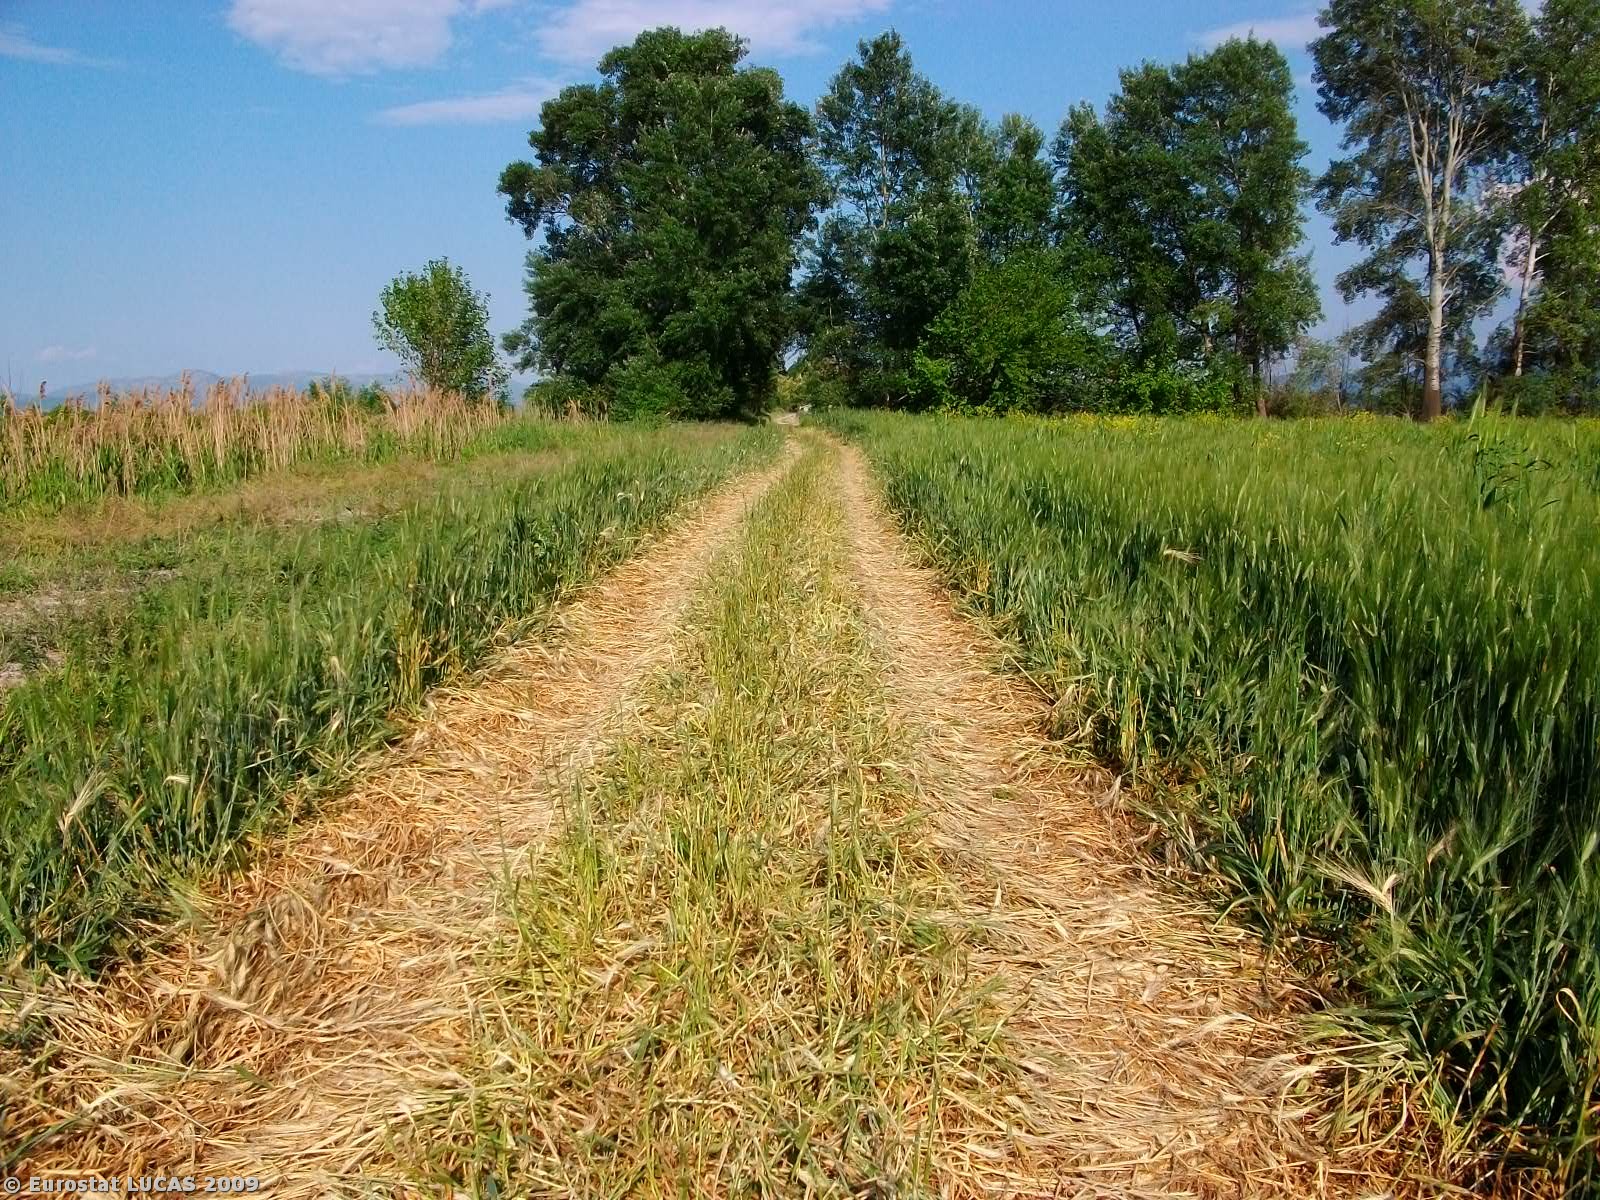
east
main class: Cropland
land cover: Durum wheat
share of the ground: > 75 %
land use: Agriculture (excluding fallow land and kitchen gardens)
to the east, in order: Durum wheat; Lines of trees; Ditches and canals; Paved roads, cycling and walking lanes; Lines of trees; Maize; Spontaneously vegetated surfaces
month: May
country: GR
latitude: 38.4180
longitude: 23.0713
